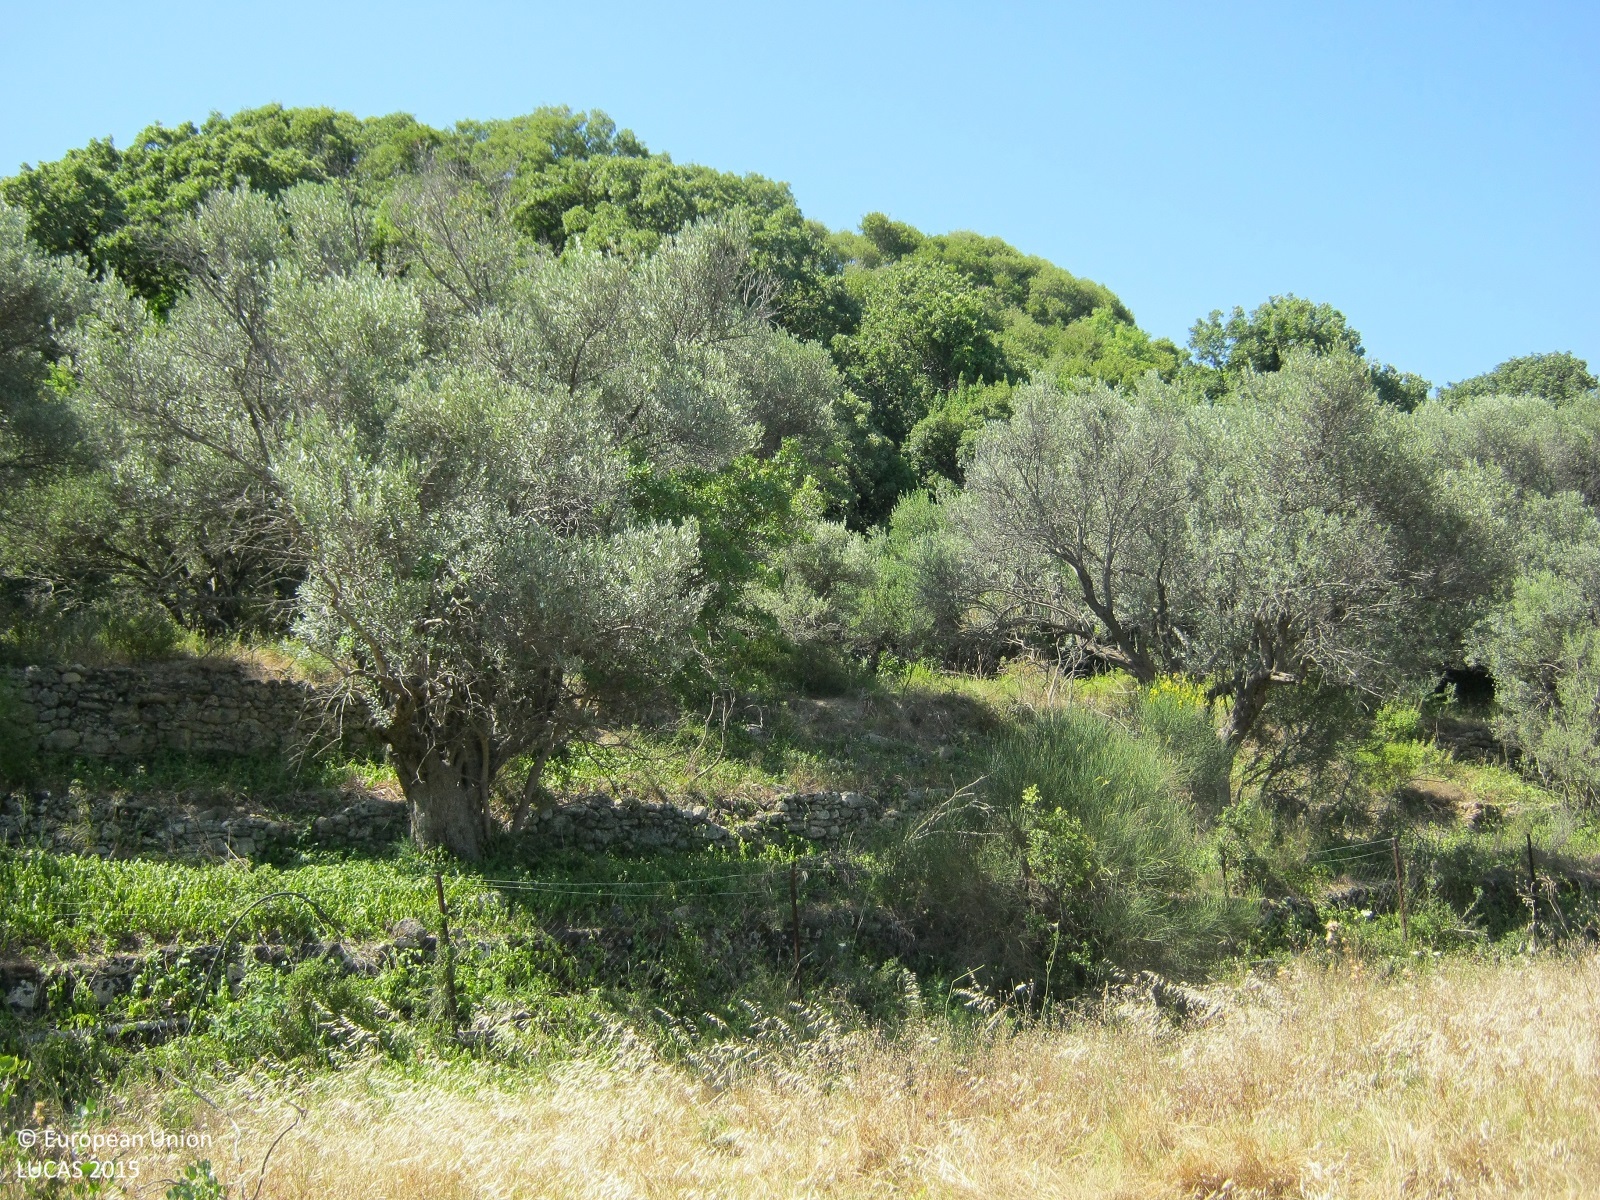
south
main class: Shrubland
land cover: Shrubland without tree cover
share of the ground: > 75 %
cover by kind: shrubs 90 %, herbaceous plants 10 %
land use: Semi-natural and natural areas not in use
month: June
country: GR
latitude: 36.4034
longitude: 28.0959
